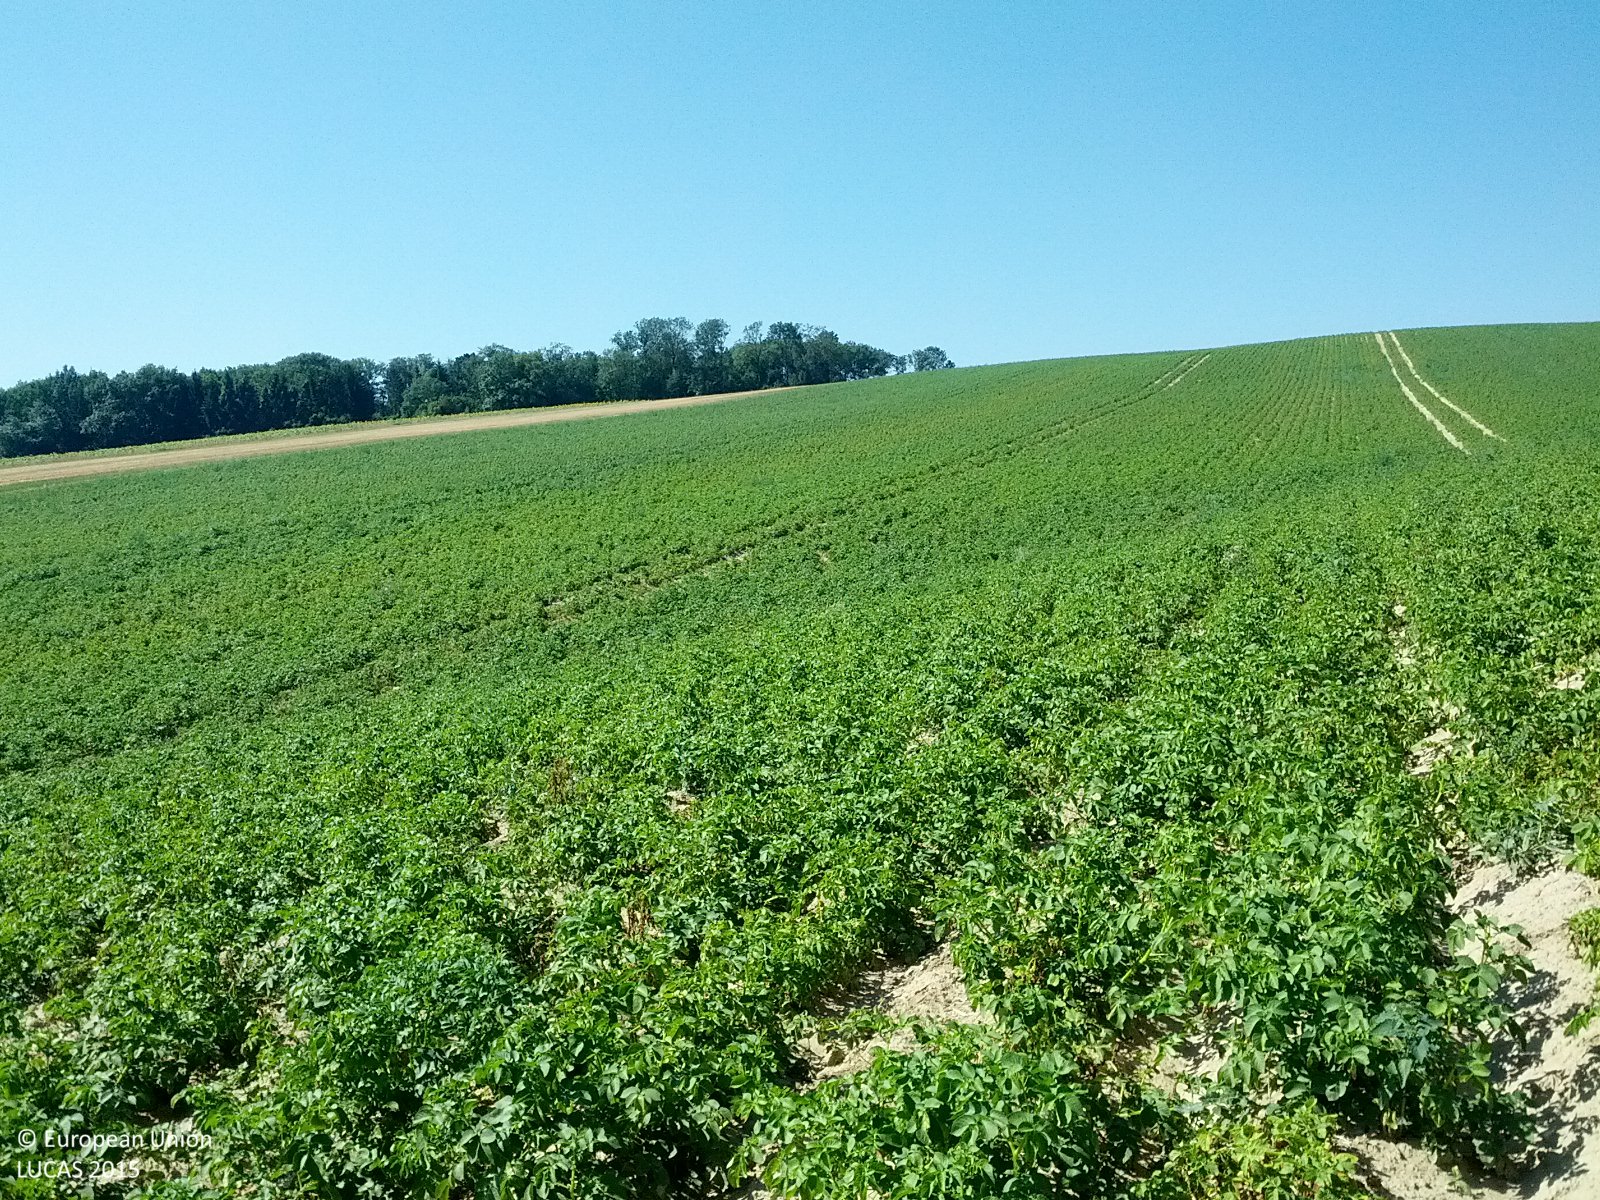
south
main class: Cropland
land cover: Potatoes
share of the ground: > 75 %
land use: Agriculture (excluding fallow land and kitchen gardens)
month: July
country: AT
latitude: 48.4679
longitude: 16.1315
